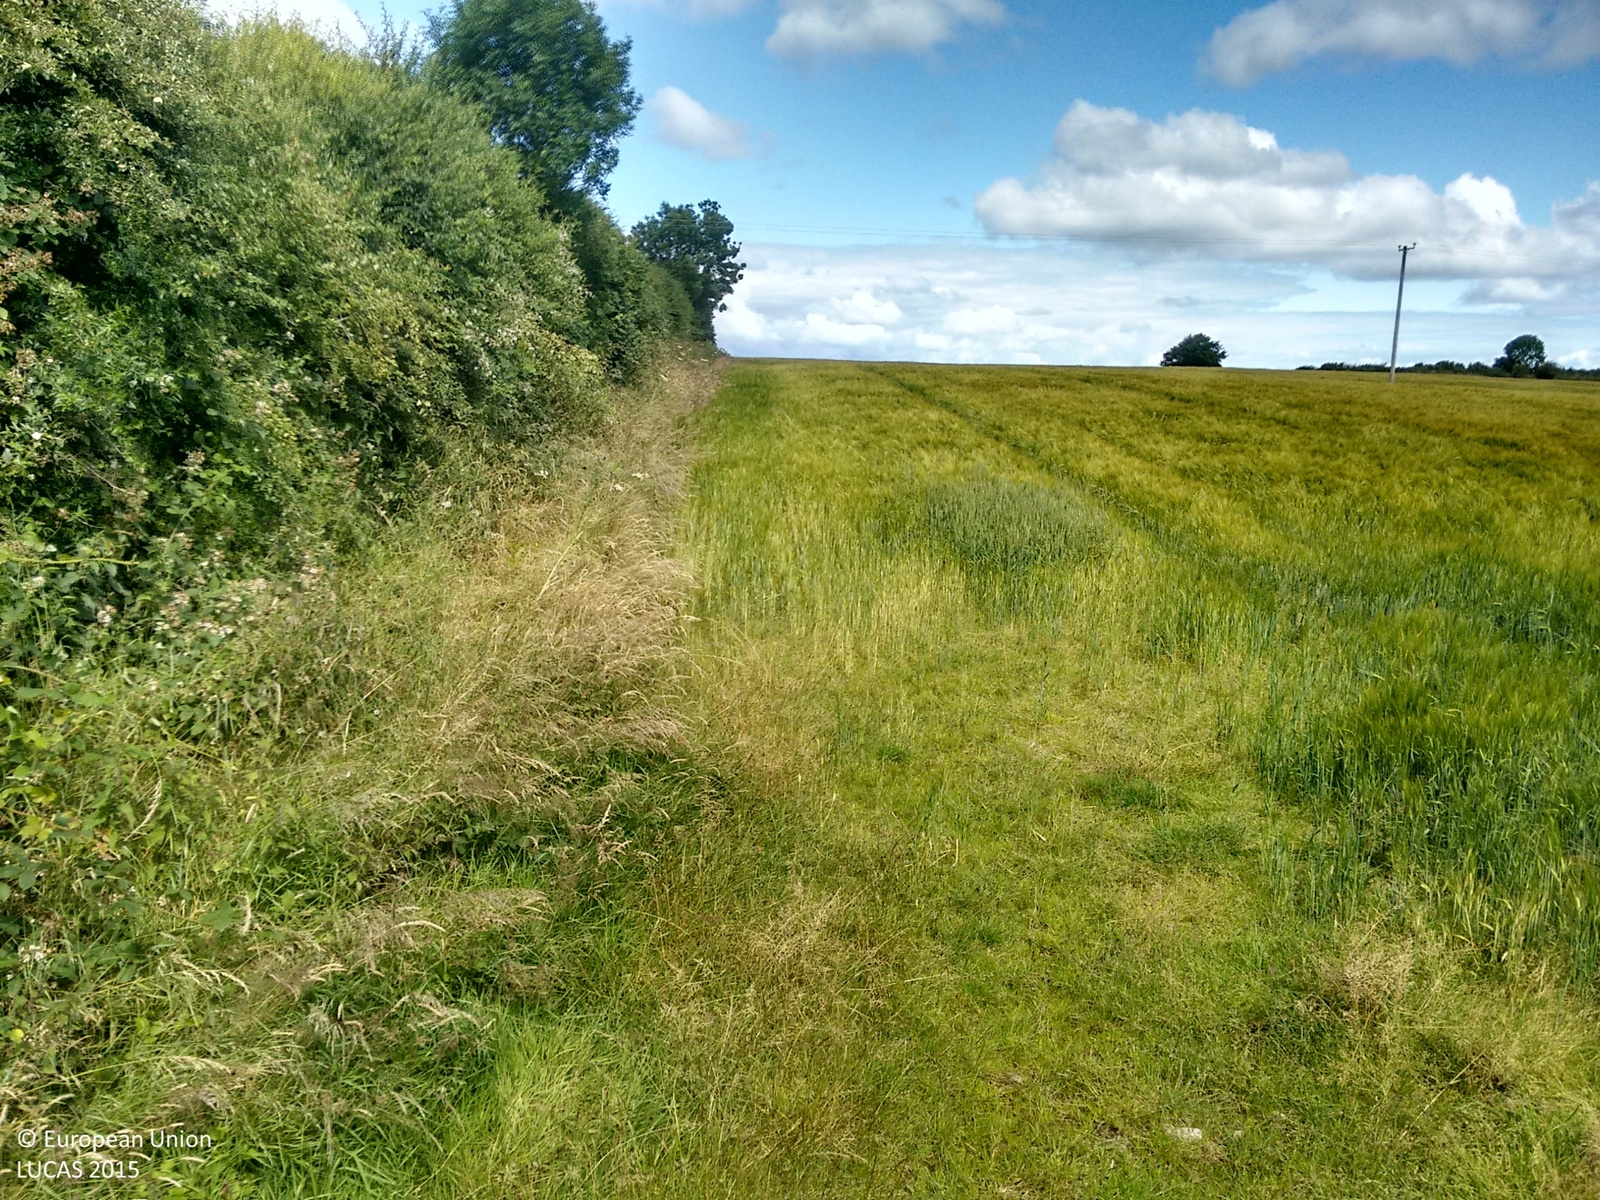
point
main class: Cropland
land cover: Barley
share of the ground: > 75 %
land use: Agriculture (excluding fallow land and kitchen gardens)
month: July
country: IE
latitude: 52.2203
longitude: -8.9323
